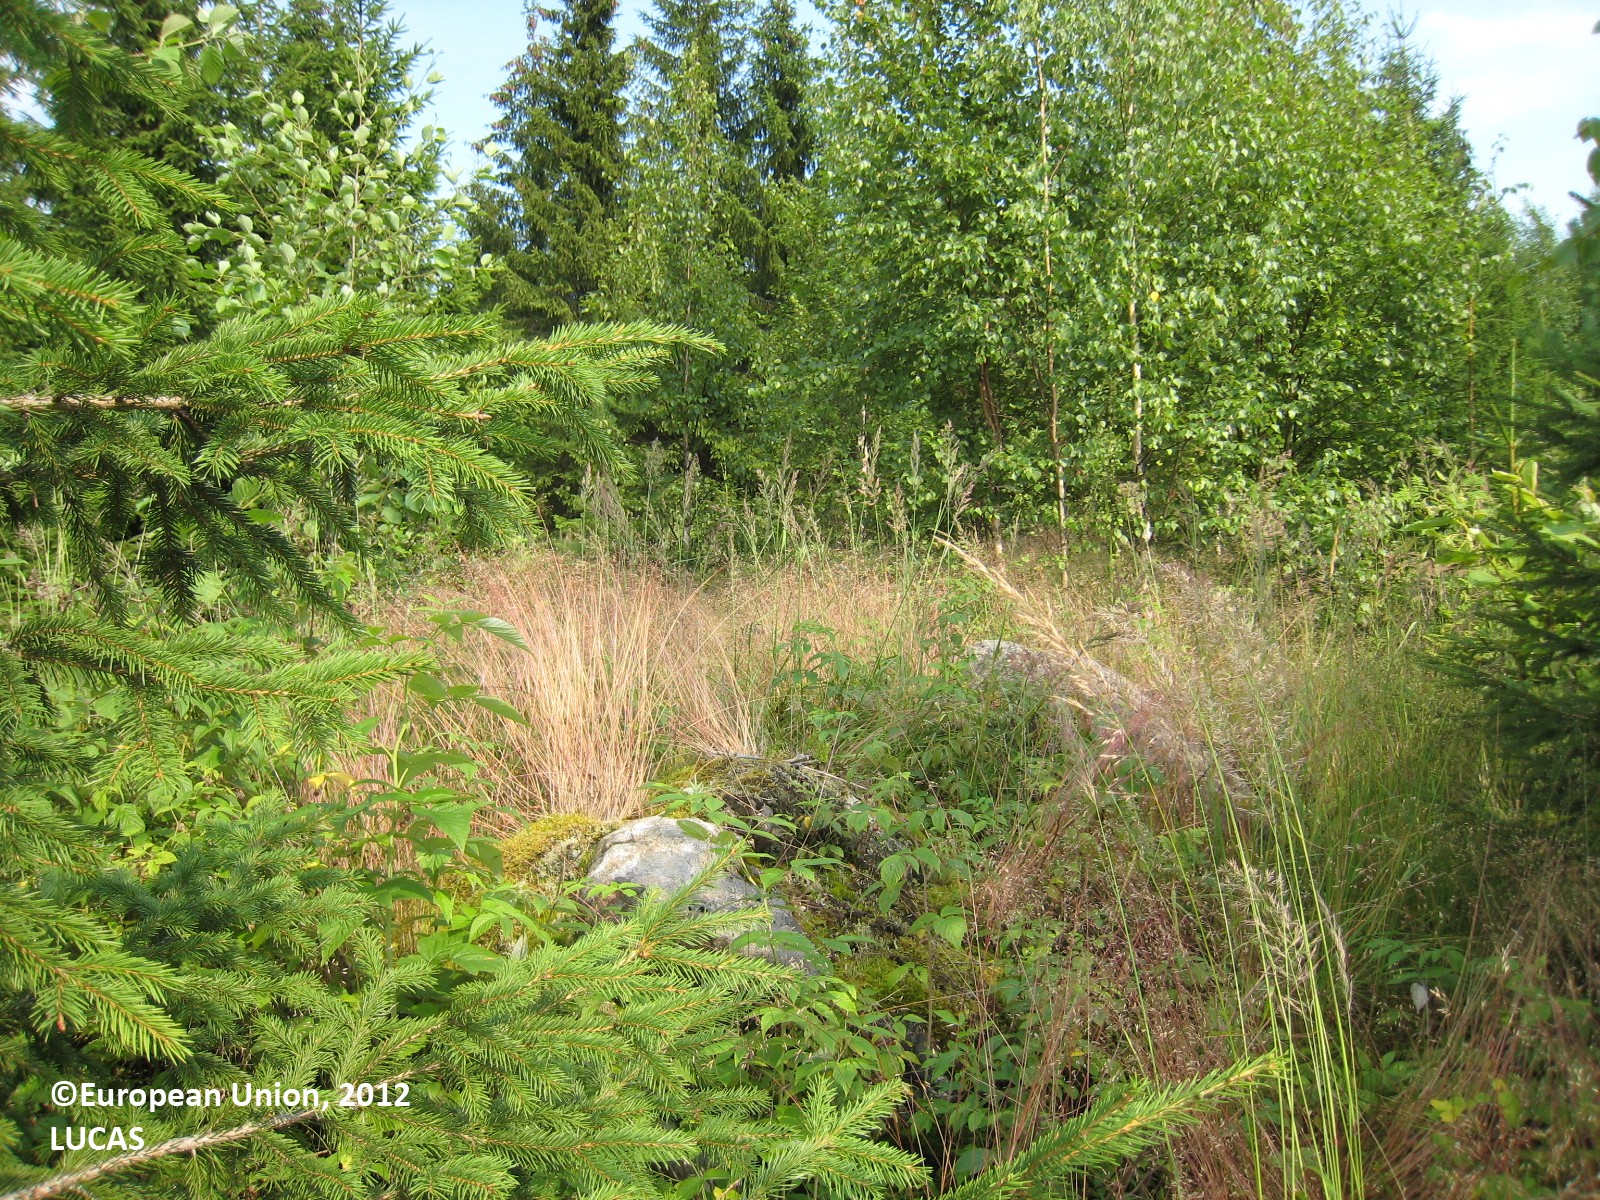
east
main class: Woodland
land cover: Other mixed woodland
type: boreal forest
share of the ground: 50 - 75 %
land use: Forestry
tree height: < 5 m
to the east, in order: Other mixed woodland; Spruce dominated mixed woodland; Other mixed woodland; Spruce dominated coniferous woodland; Spruce dominated mixed woodland; Ditches and canals; Other bare soil; Spruce dominated coniferous woodland
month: July
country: FI
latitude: 62.4066
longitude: 27.3682
